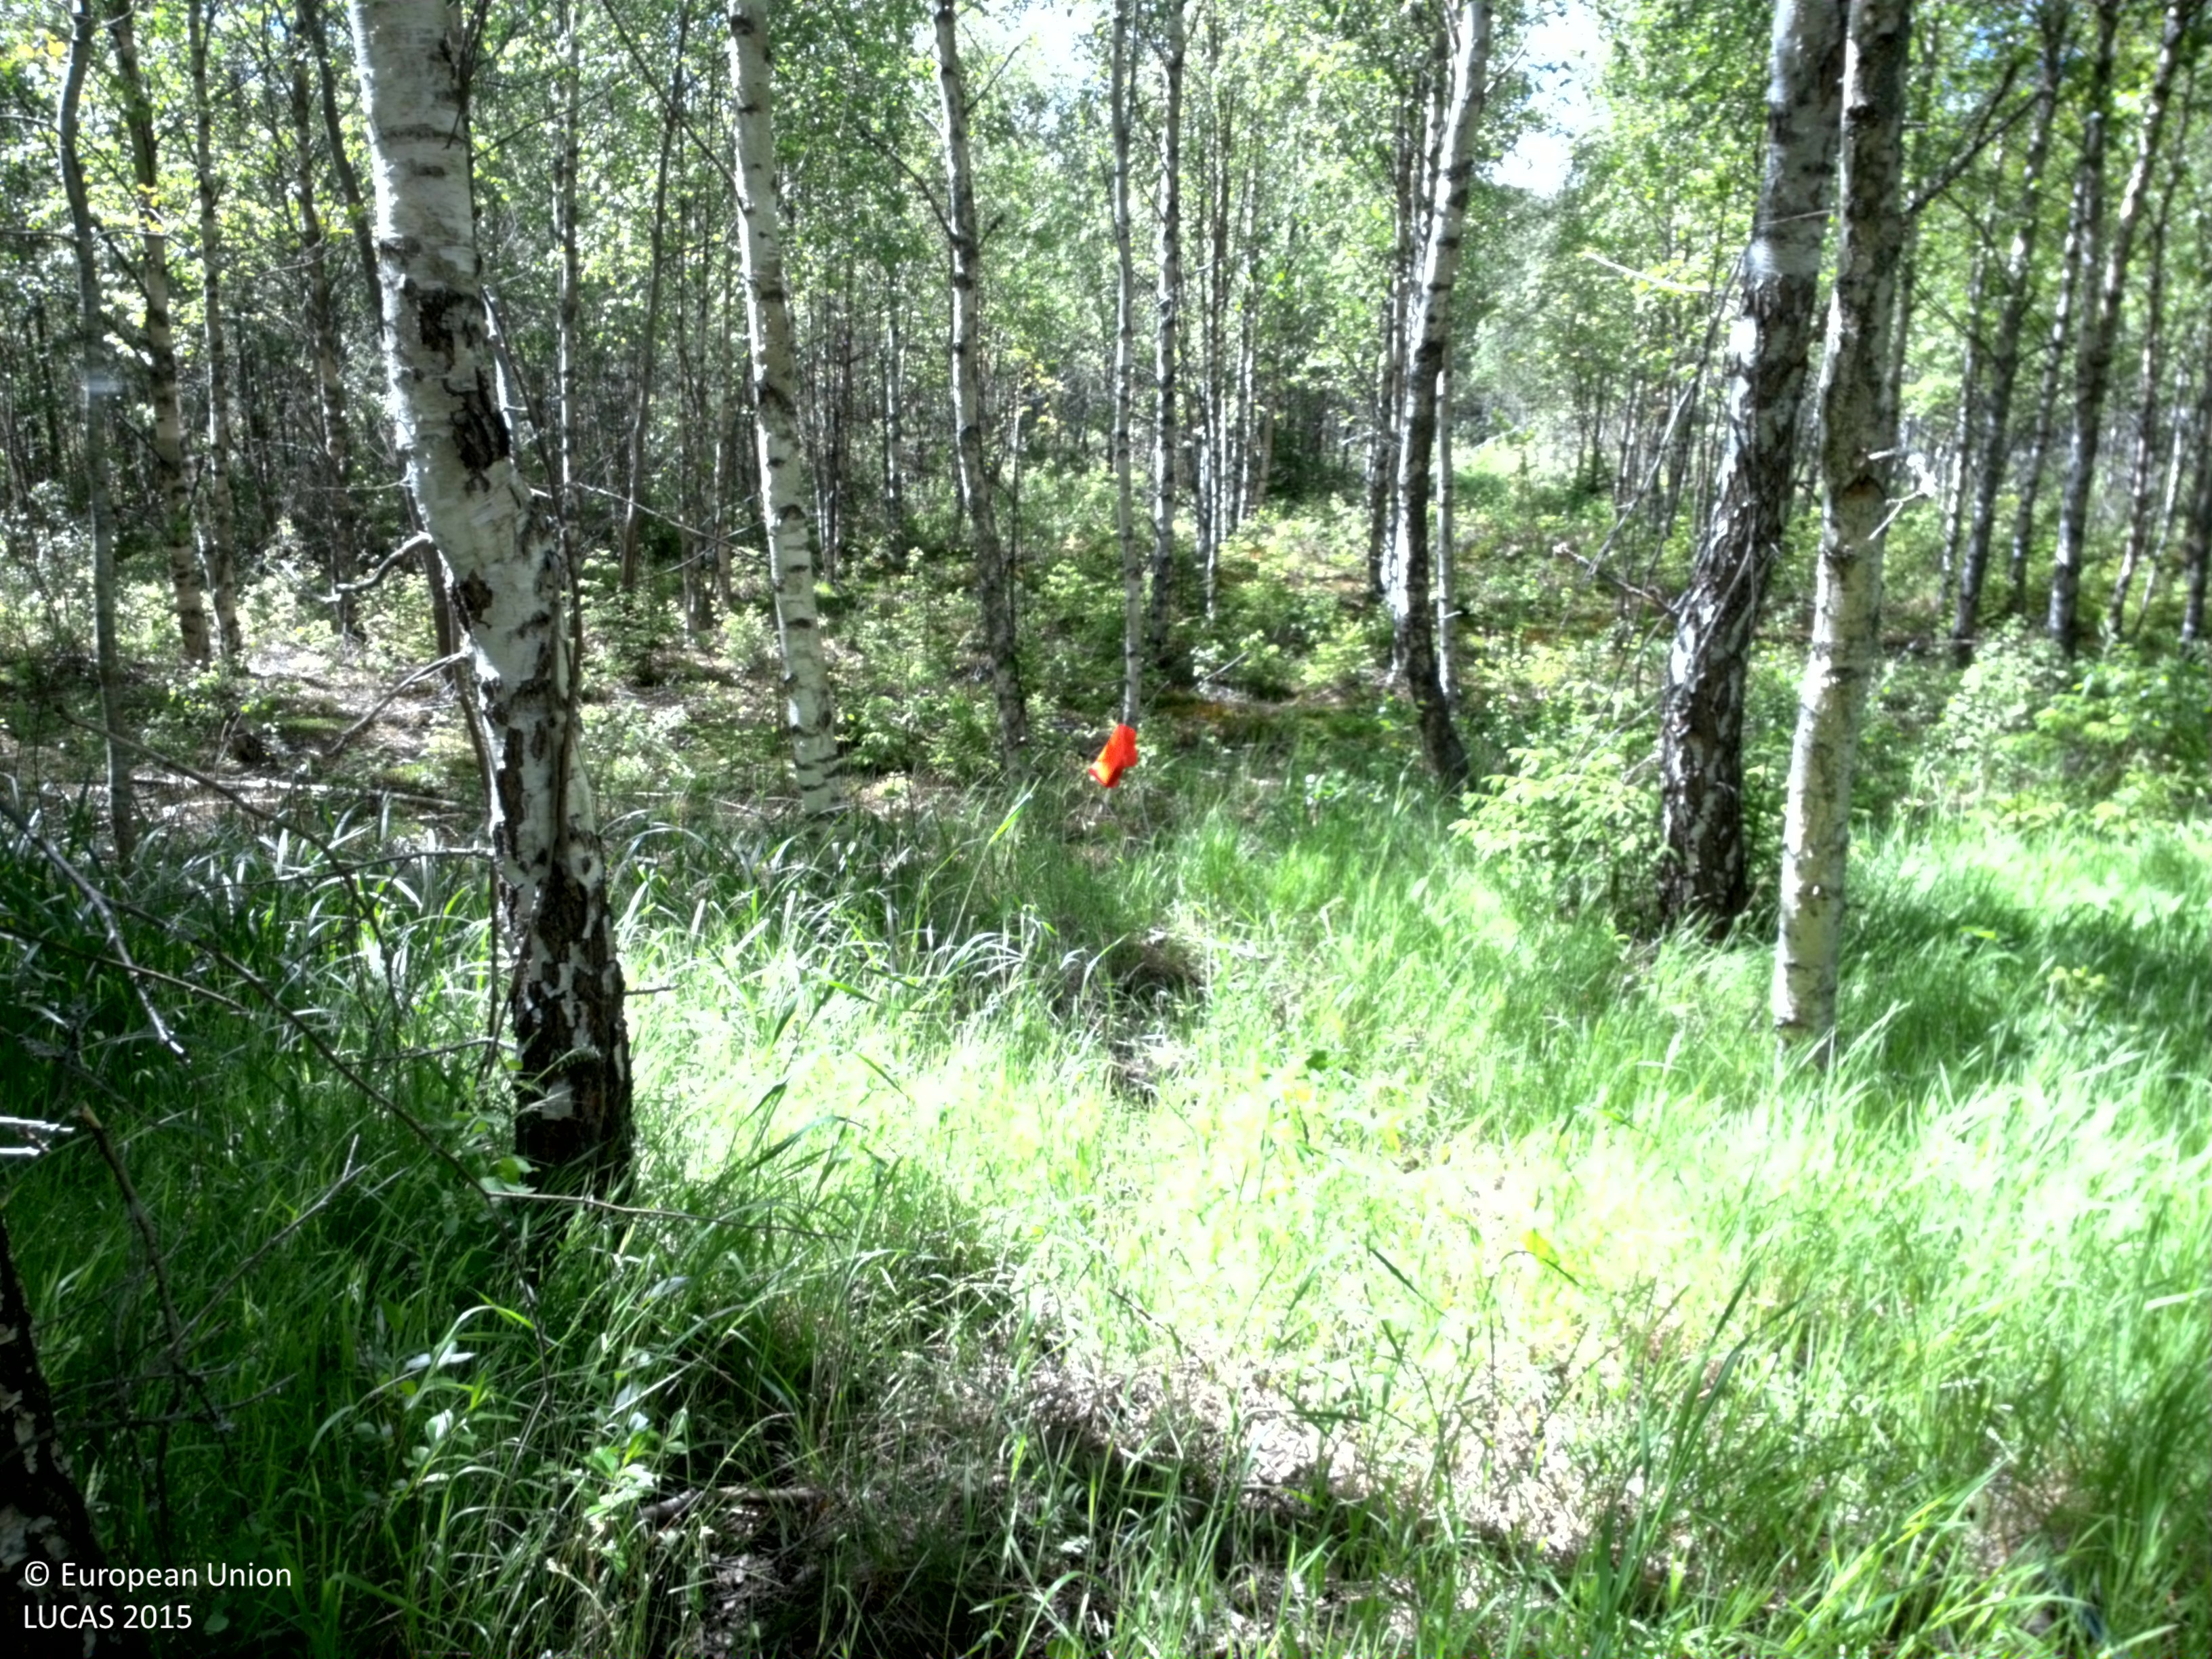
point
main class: Woodland
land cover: Broadleaved woodland
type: acidophilous oak and oak-birch forest
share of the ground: 25 - 50 %
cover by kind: herbaceous plants 50 %, broadleaved forest trees 35 %, lichens and mosses 10 %, coniferous forest trees 5 %
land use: Forestry
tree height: > 5 m
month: June
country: SE
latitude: 58.6875
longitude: 16.2571
